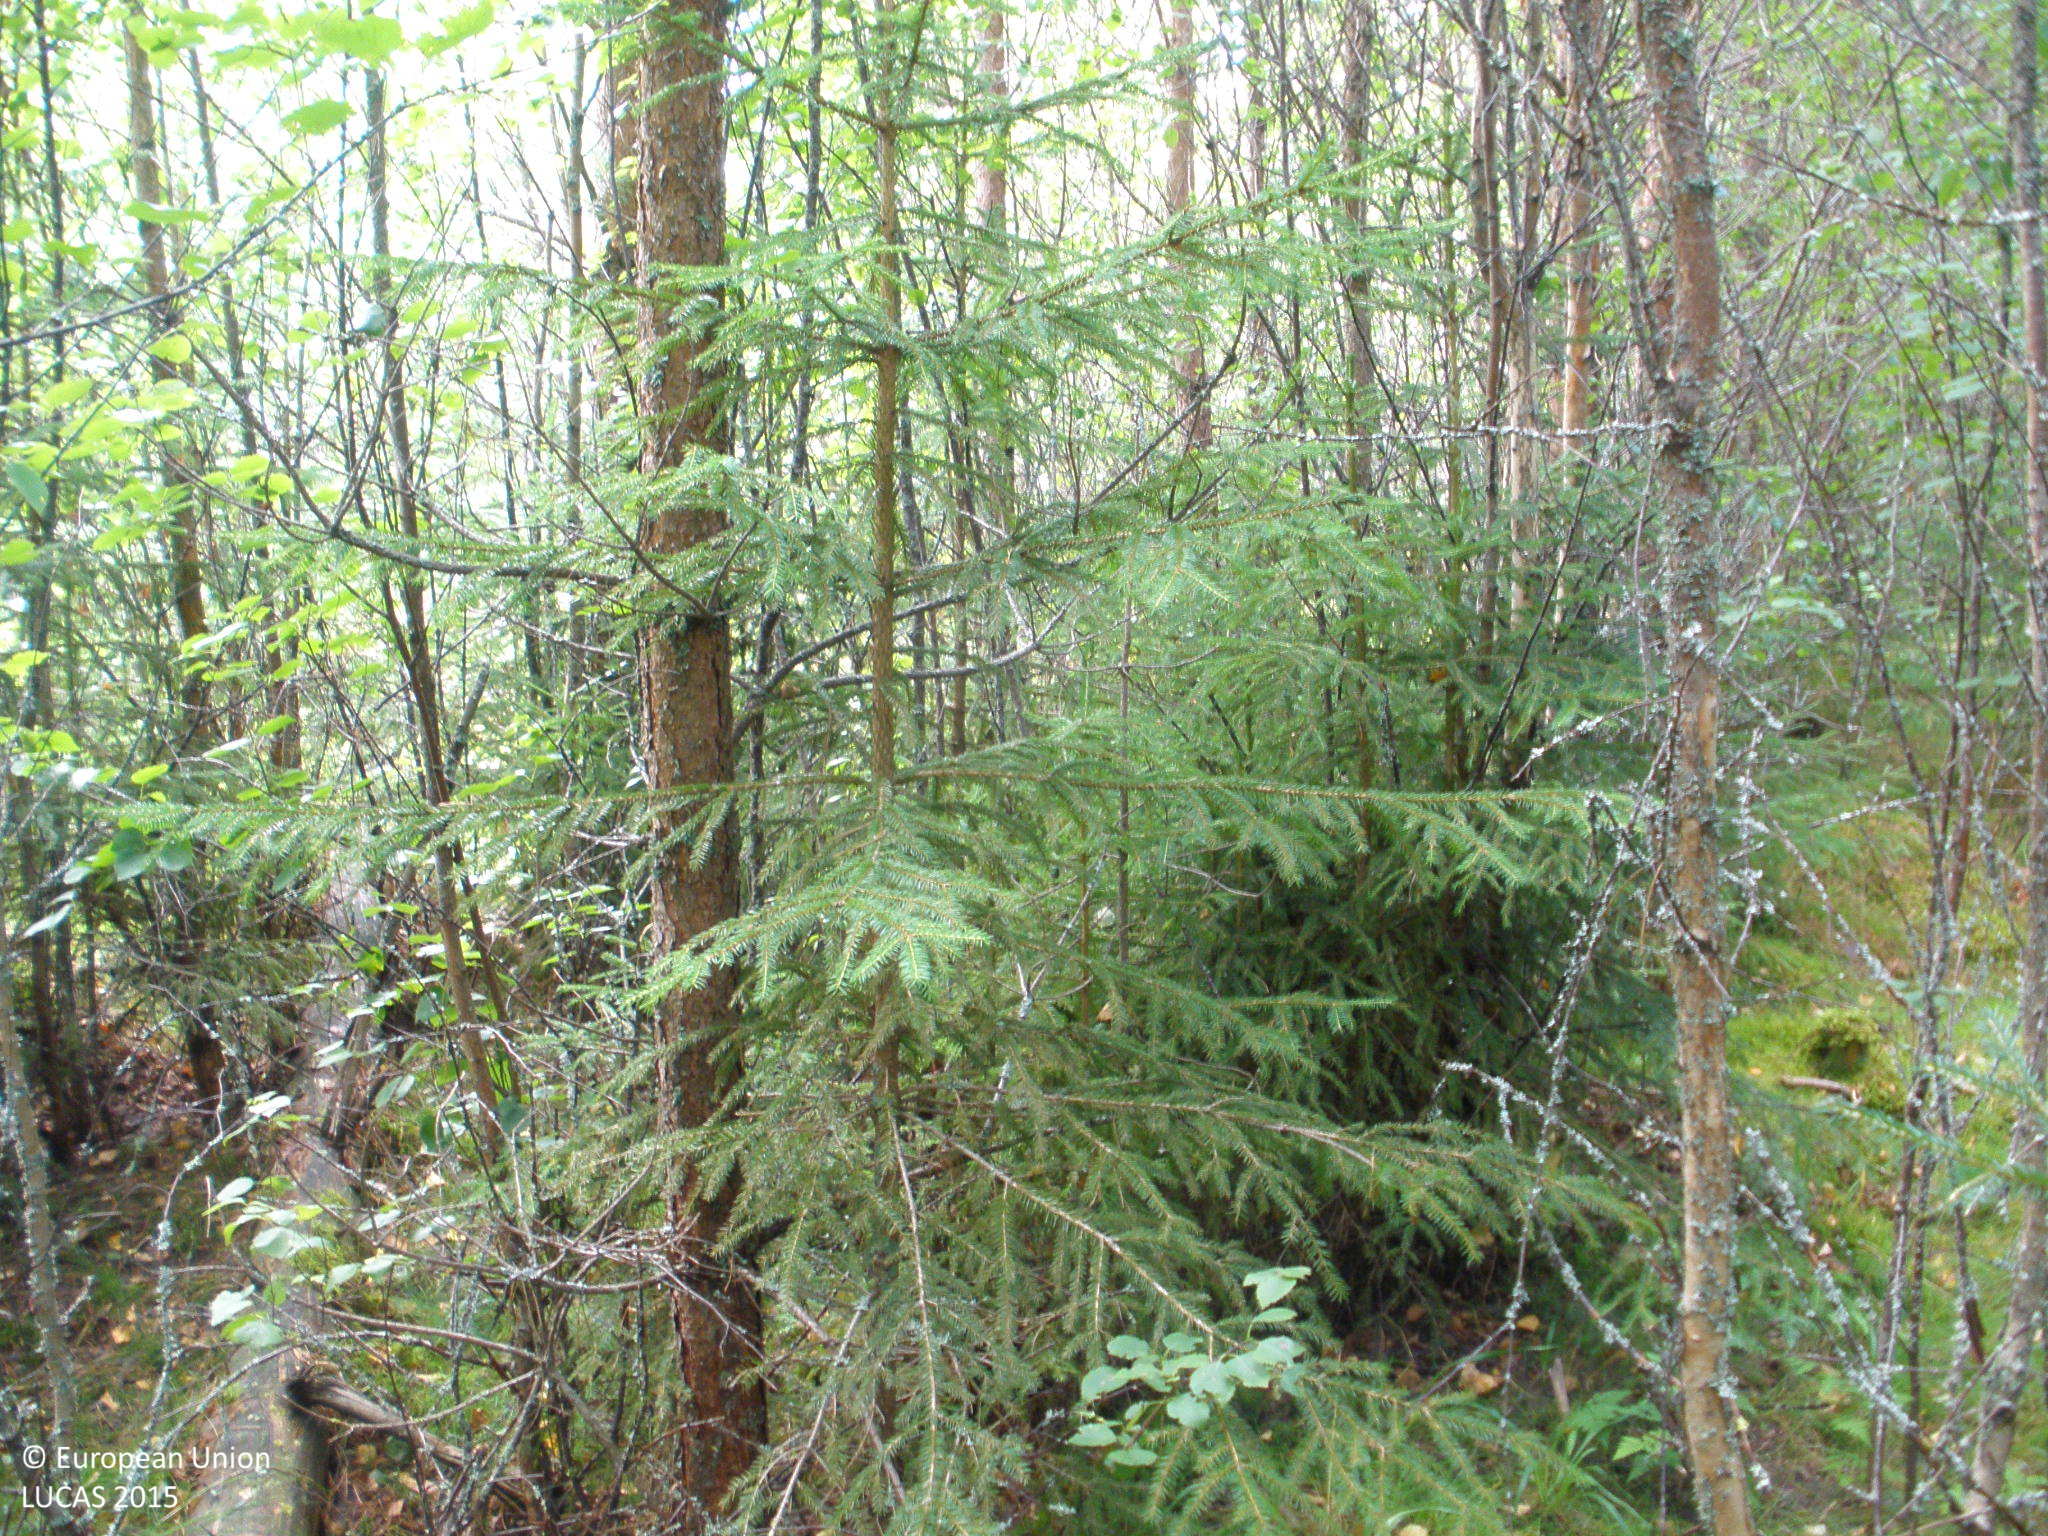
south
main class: Woodland
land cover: Pine dominated mixed woodland
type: boreal forest
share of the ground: > 75 %
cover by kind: coniferous forest trees 50 %, broadleaved forest trees 30 %, herbaceous plants 10 %, lichens and mosses 10 %
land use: Forestry
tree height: > 5 m
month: August
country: FI
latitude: 60.8916
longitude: 24.3451
